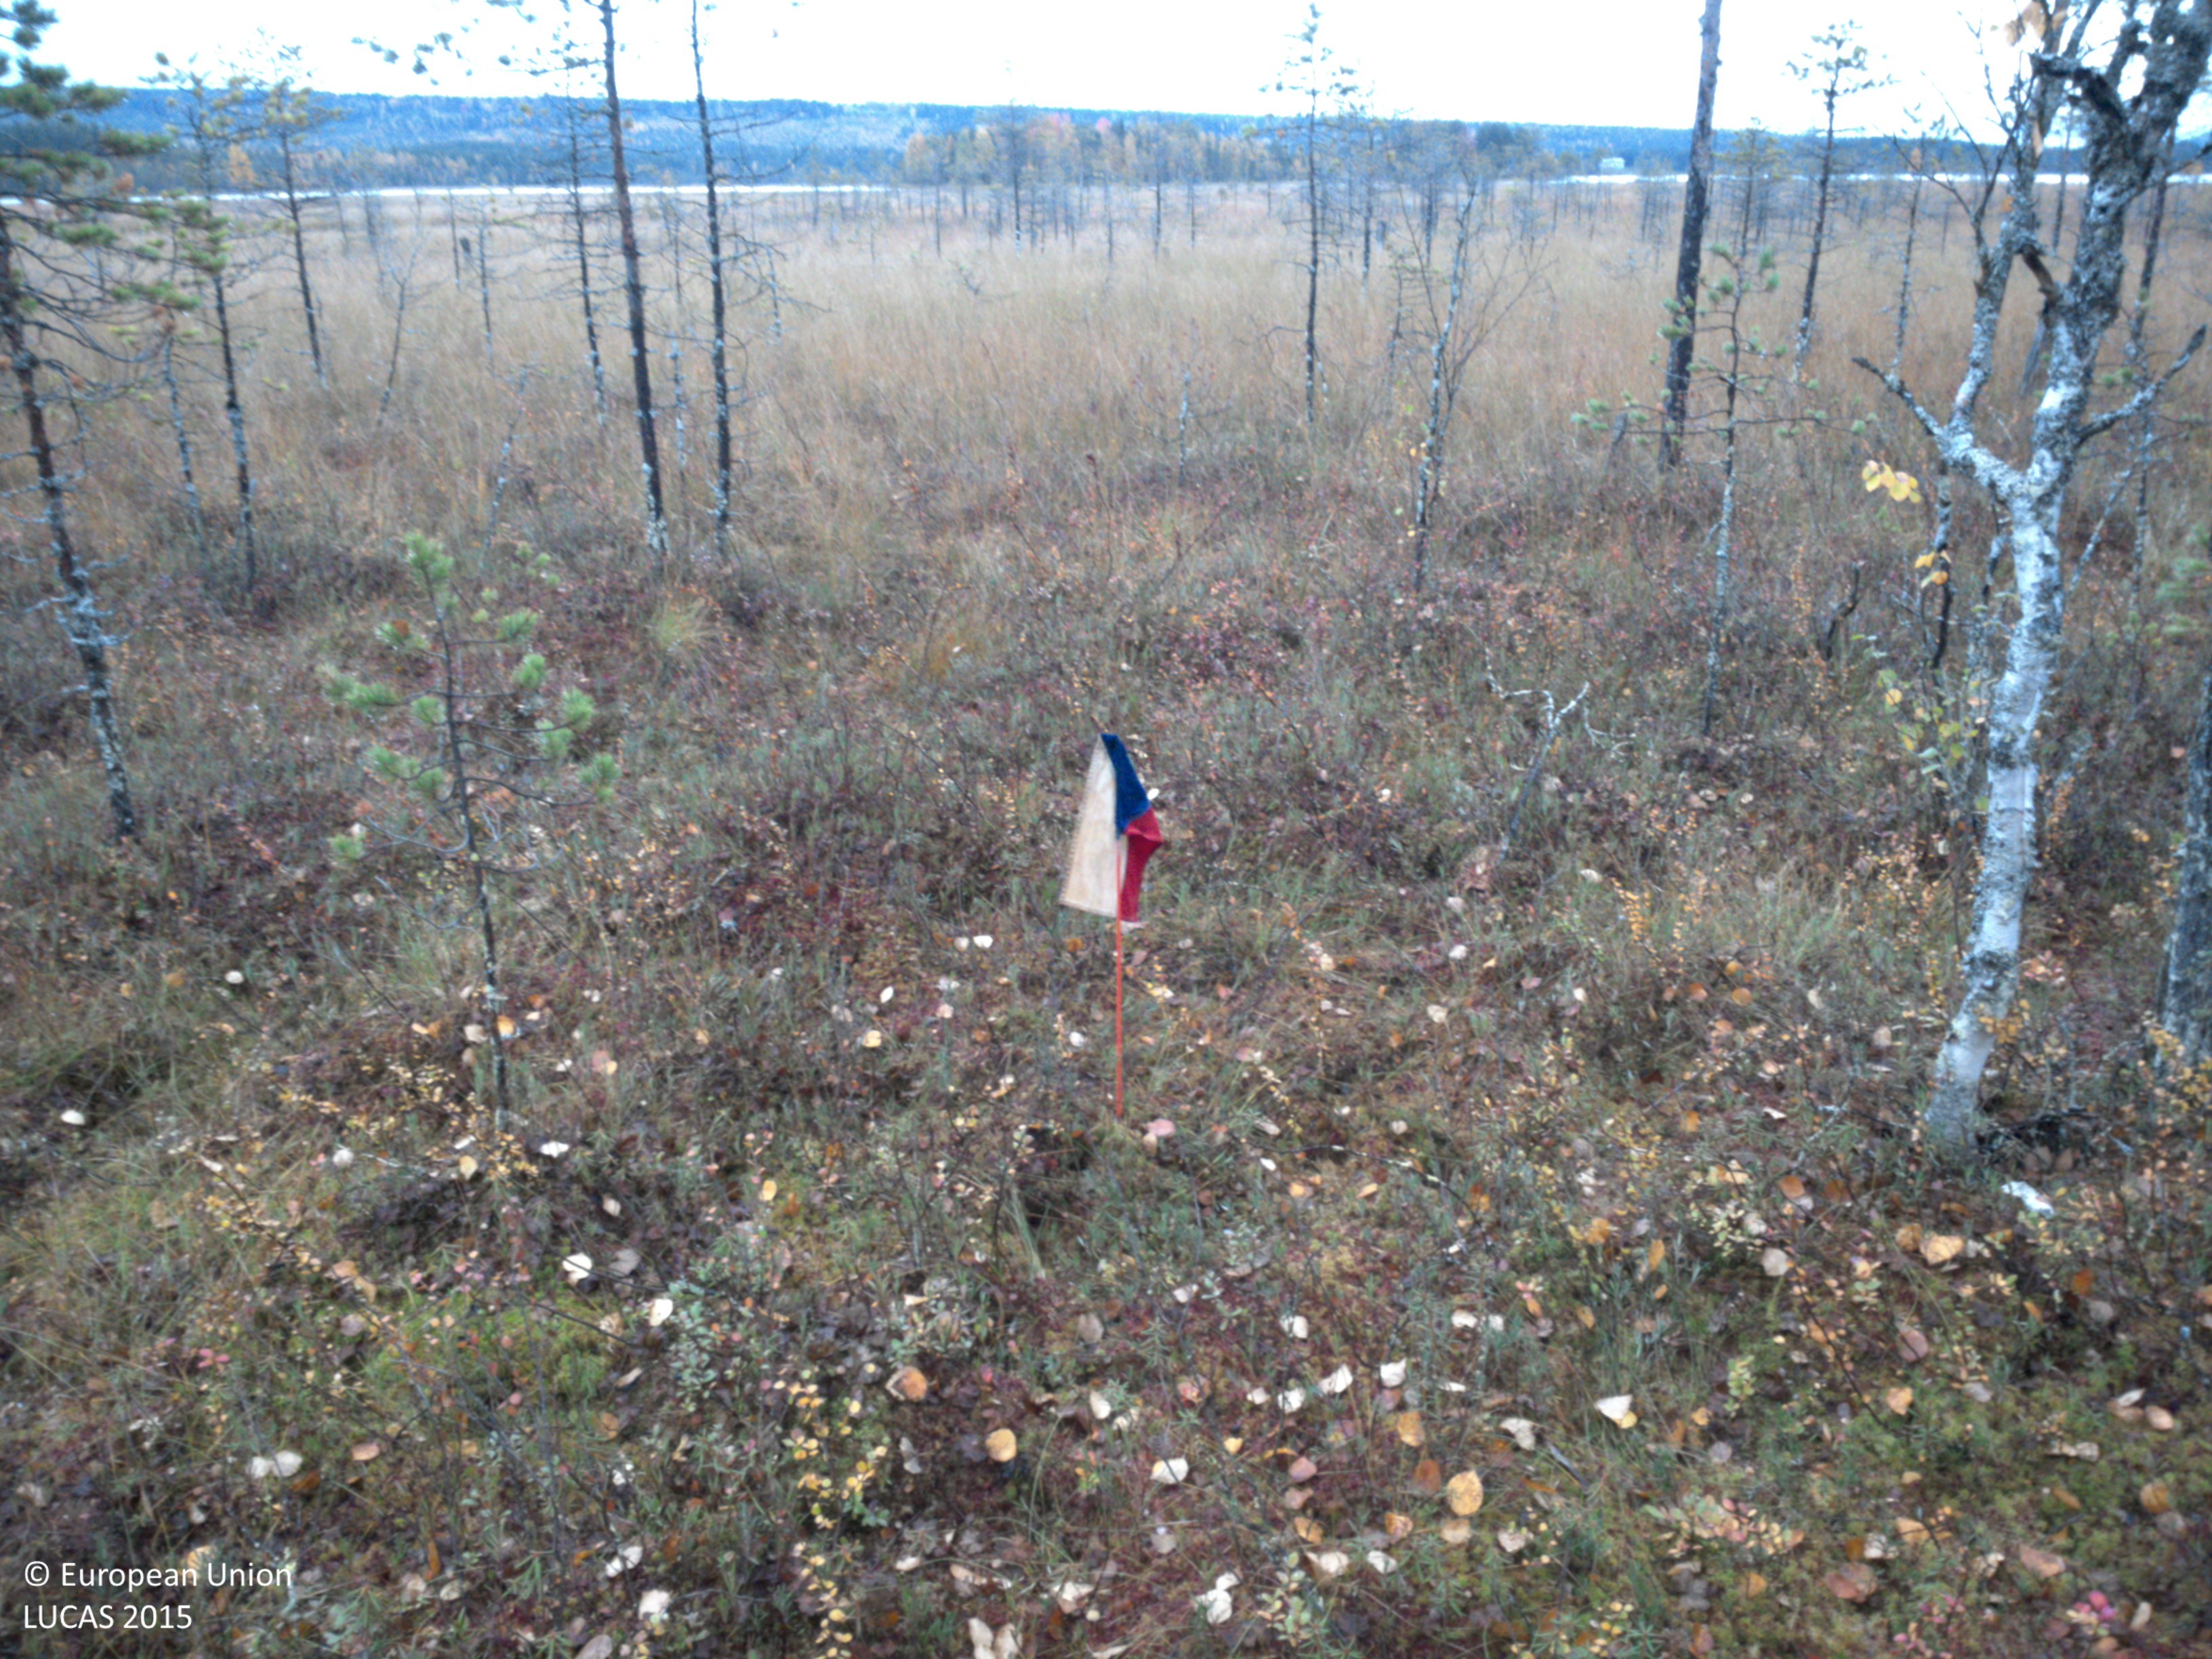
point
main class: Woodland
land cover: Pine dominated coniferous woodland
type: boreal forest
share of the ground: 25 - 50 %
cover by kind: shrubs 30 %, coniferous forest trees 25 %, herbaceous plants 20 %, lichens and mosses 20 %, broadleaved forest trees 5 %
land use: Forestry
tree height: < 5 m
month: September
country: SE
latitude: 65.0013
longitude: 18.9361
